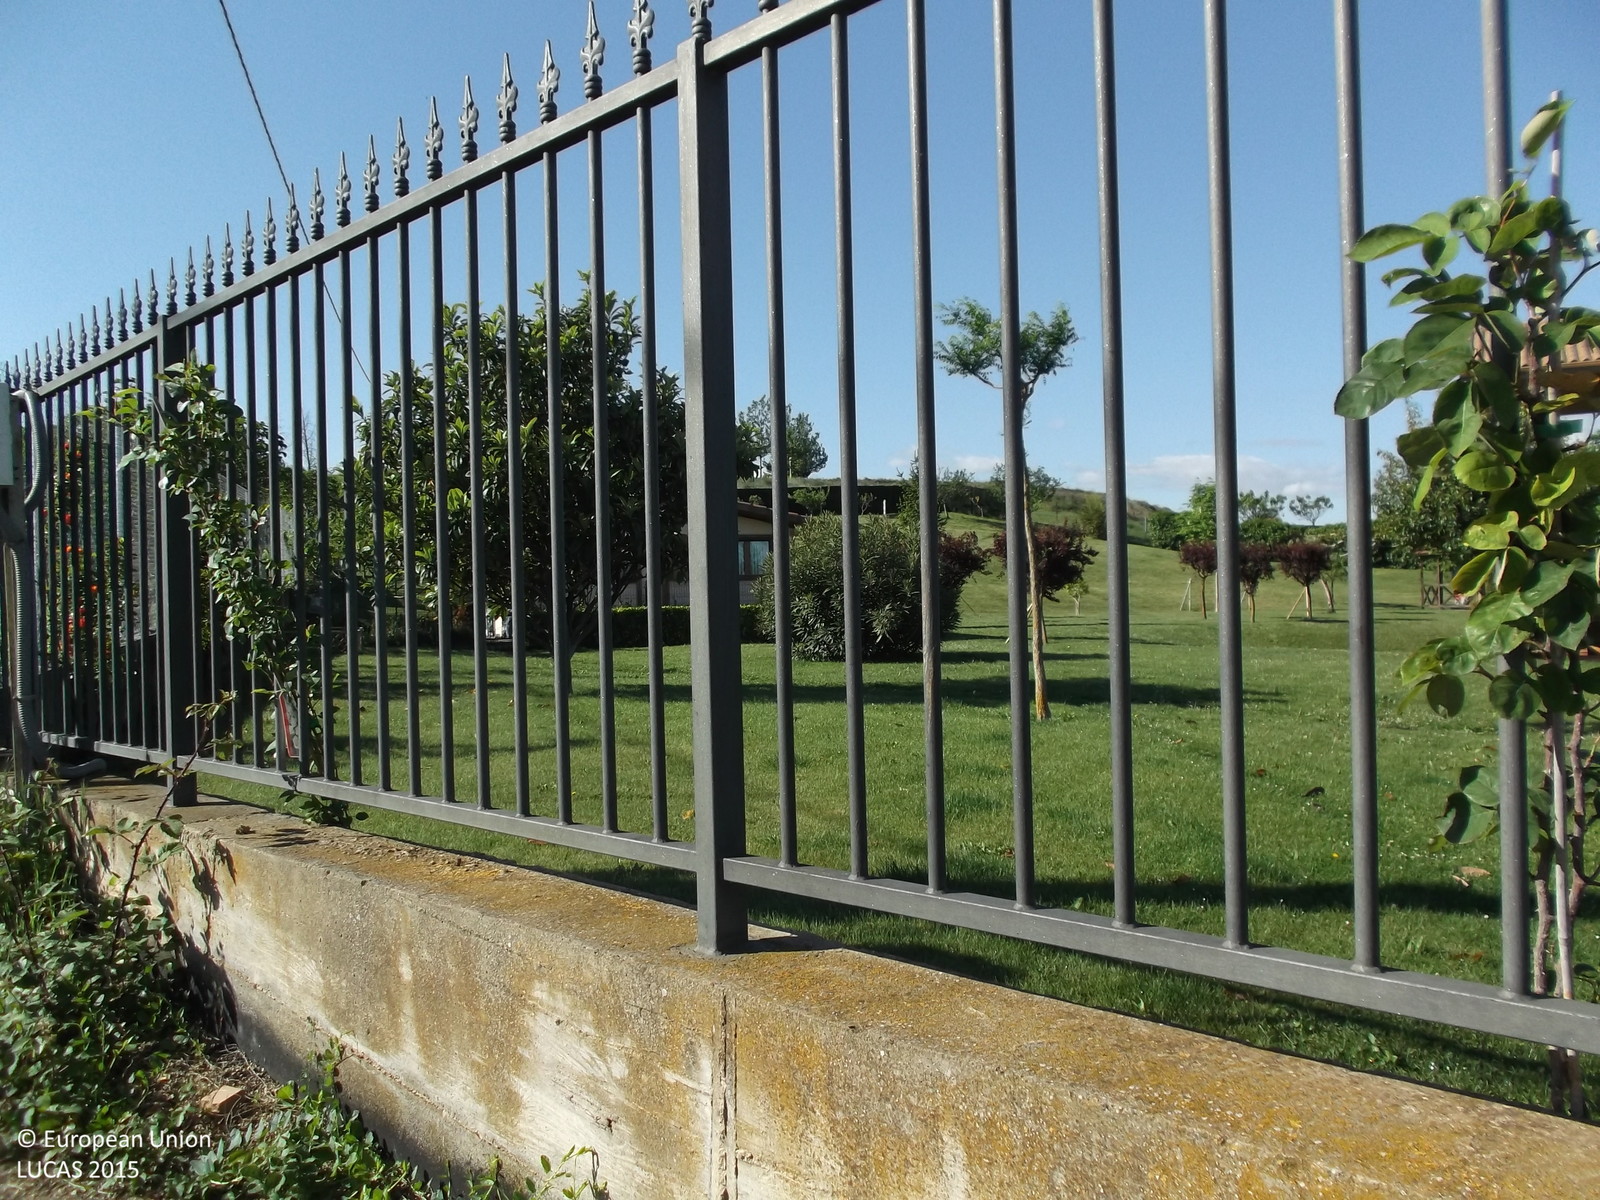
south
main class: Grassland
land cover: Grassland without tree/shrub cover
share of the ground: > 75 %
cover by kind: herbaceous plants 100 %
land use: Residential
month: May
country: ES
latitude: 42.4148
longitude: -2.4270
